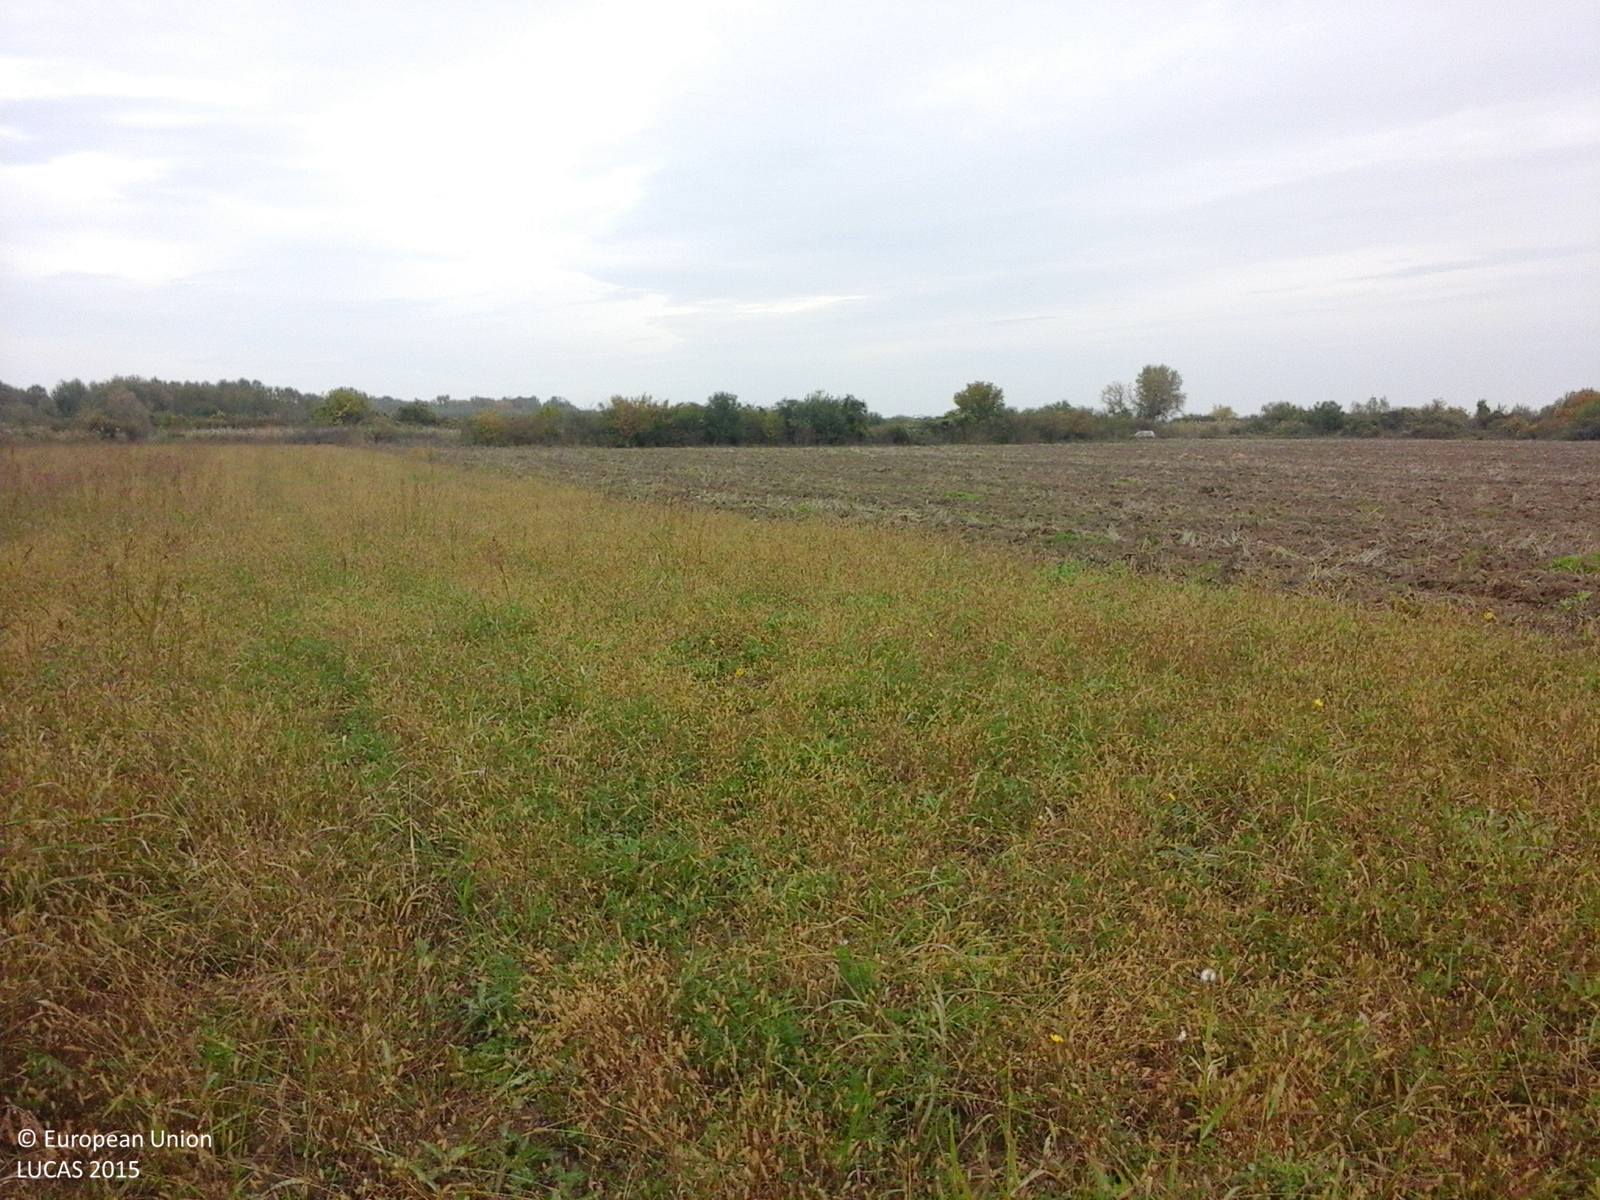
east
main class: Grassland
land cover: Spontaneously vegetated surfaces
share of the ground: > 75 %
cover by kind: herbaceous plants 100 %
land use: Fallow land
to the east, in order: Spontaneously vegetated surfaces; Other bare soil; Shrubland with sparse tree cover; Maize
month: October
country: RO
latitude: 44.7990
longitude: 26.0487
